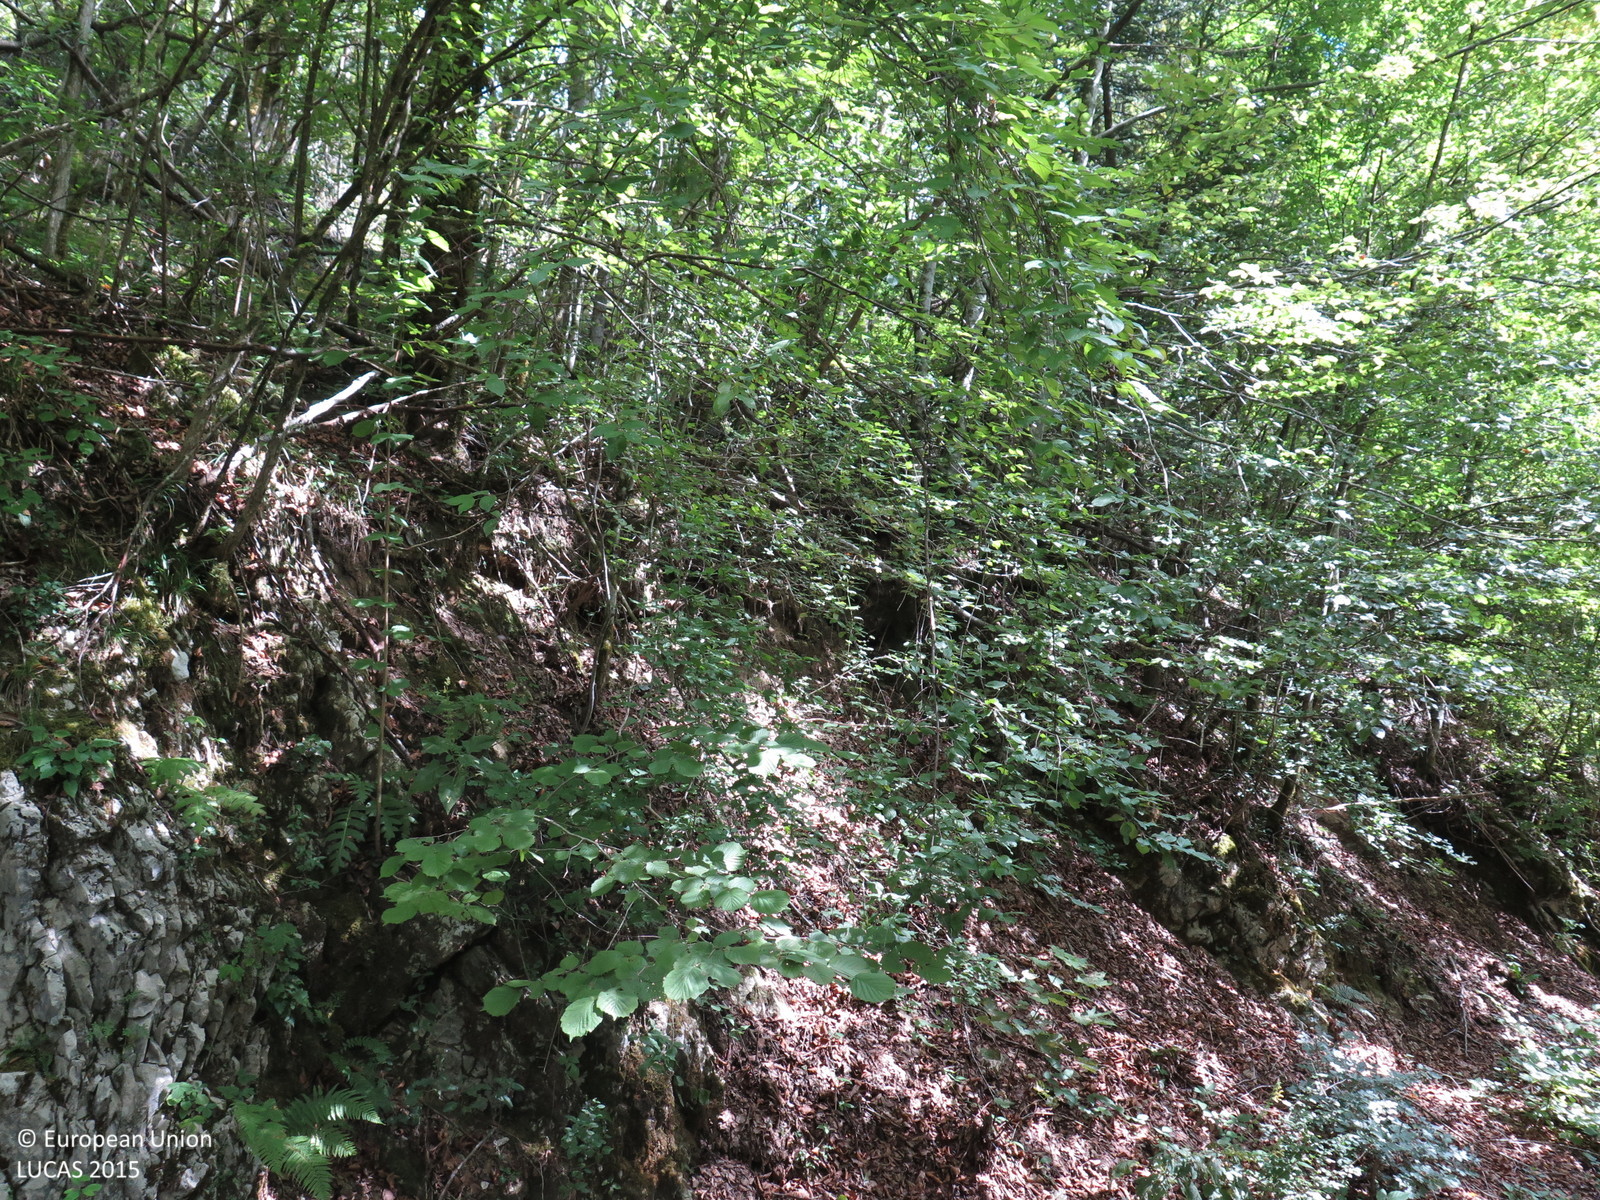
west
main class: Woodland
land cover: Broadleaved woodland
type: beech forest
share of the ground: > 75 %
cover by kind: broadleaved forest trees 90 %, shrubs 5 %, herbaceous plants 5 %
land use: Forestry
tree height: > 5 m
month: September
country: HR
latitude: 45.4870
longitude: 14.7679
